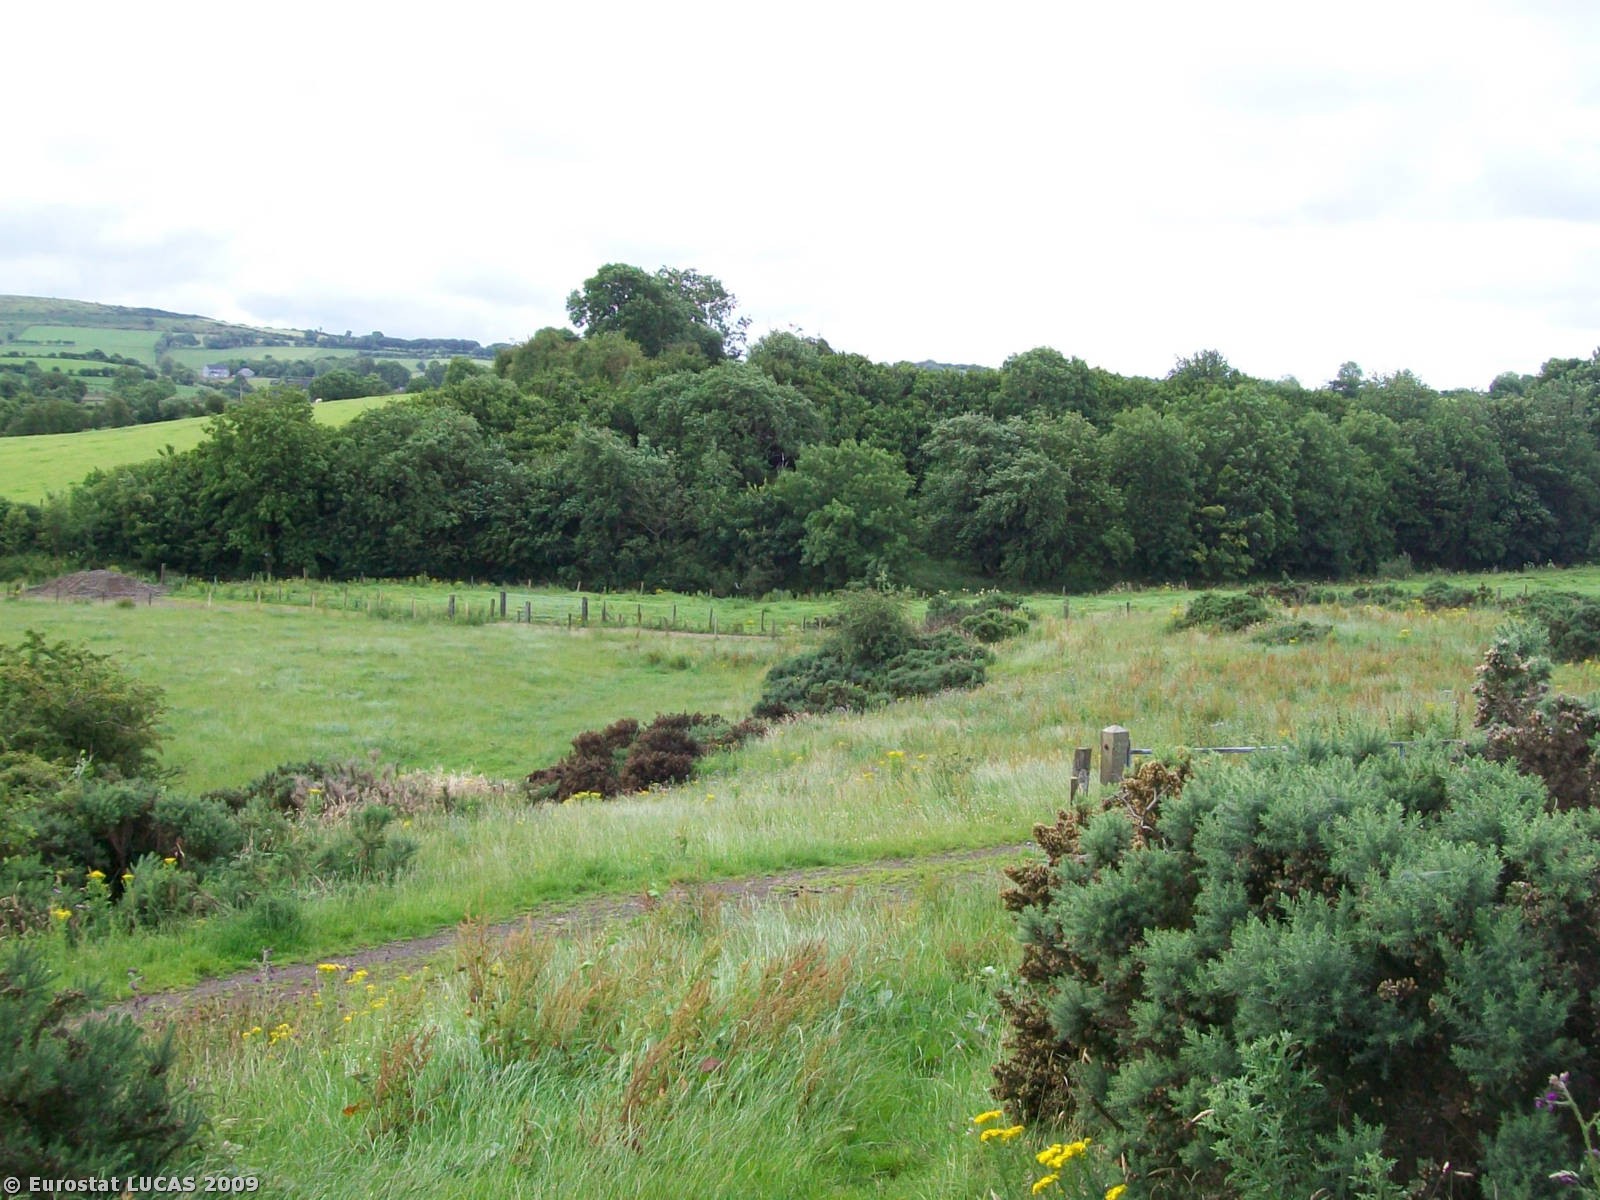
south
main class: Grassland
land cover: Grassland with sparse tree/shrub cover
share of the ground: > 75 %
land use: Agriculture (excluding fallow land and kitchen gardens)
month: July
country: GB
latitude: 54.9579
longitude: -6.2474
